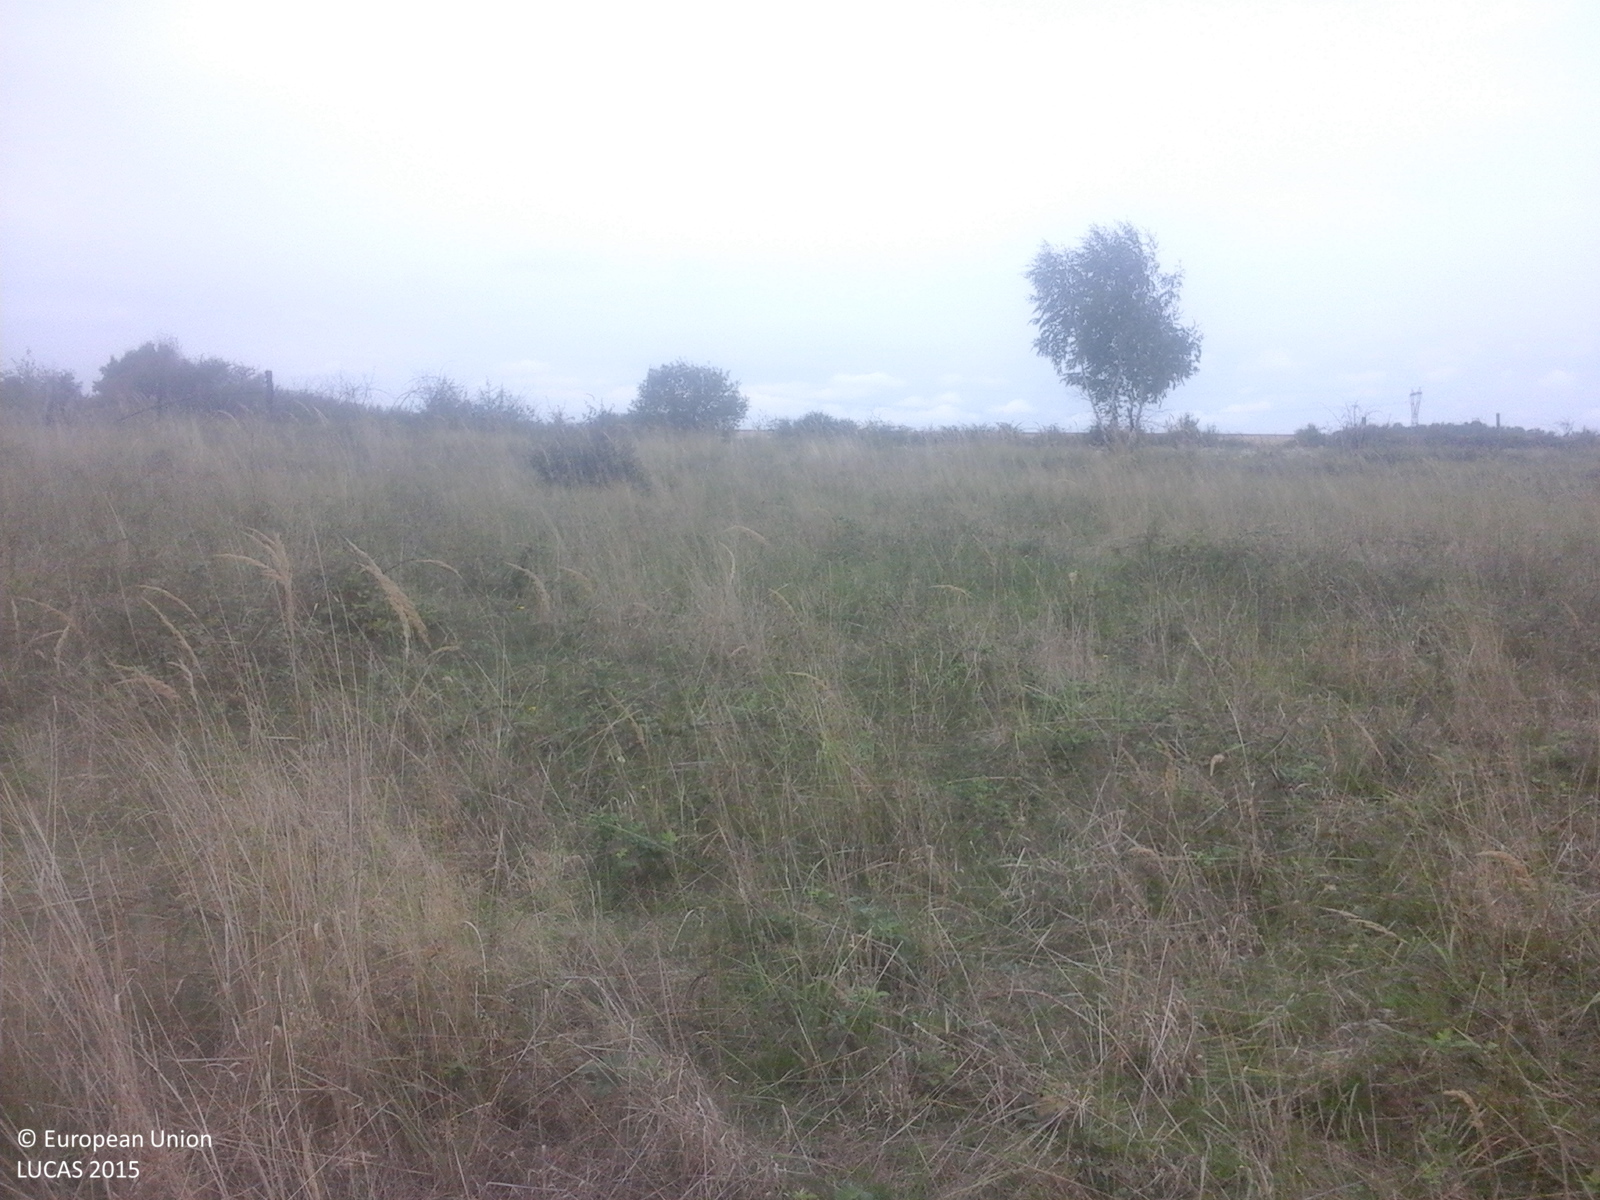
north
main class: Grassland
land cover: Grassland with sparse tree/shrub cover
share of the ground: > 75 %
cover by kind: herbaceous plants 85 %, shrubs 10 %, broadleaved forest trees 5 %
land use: Agriculture (excluding fallow land and kitchen gardens)
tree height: < 5 m
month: September
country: RO
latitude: 45.8605
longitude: 22.1108
